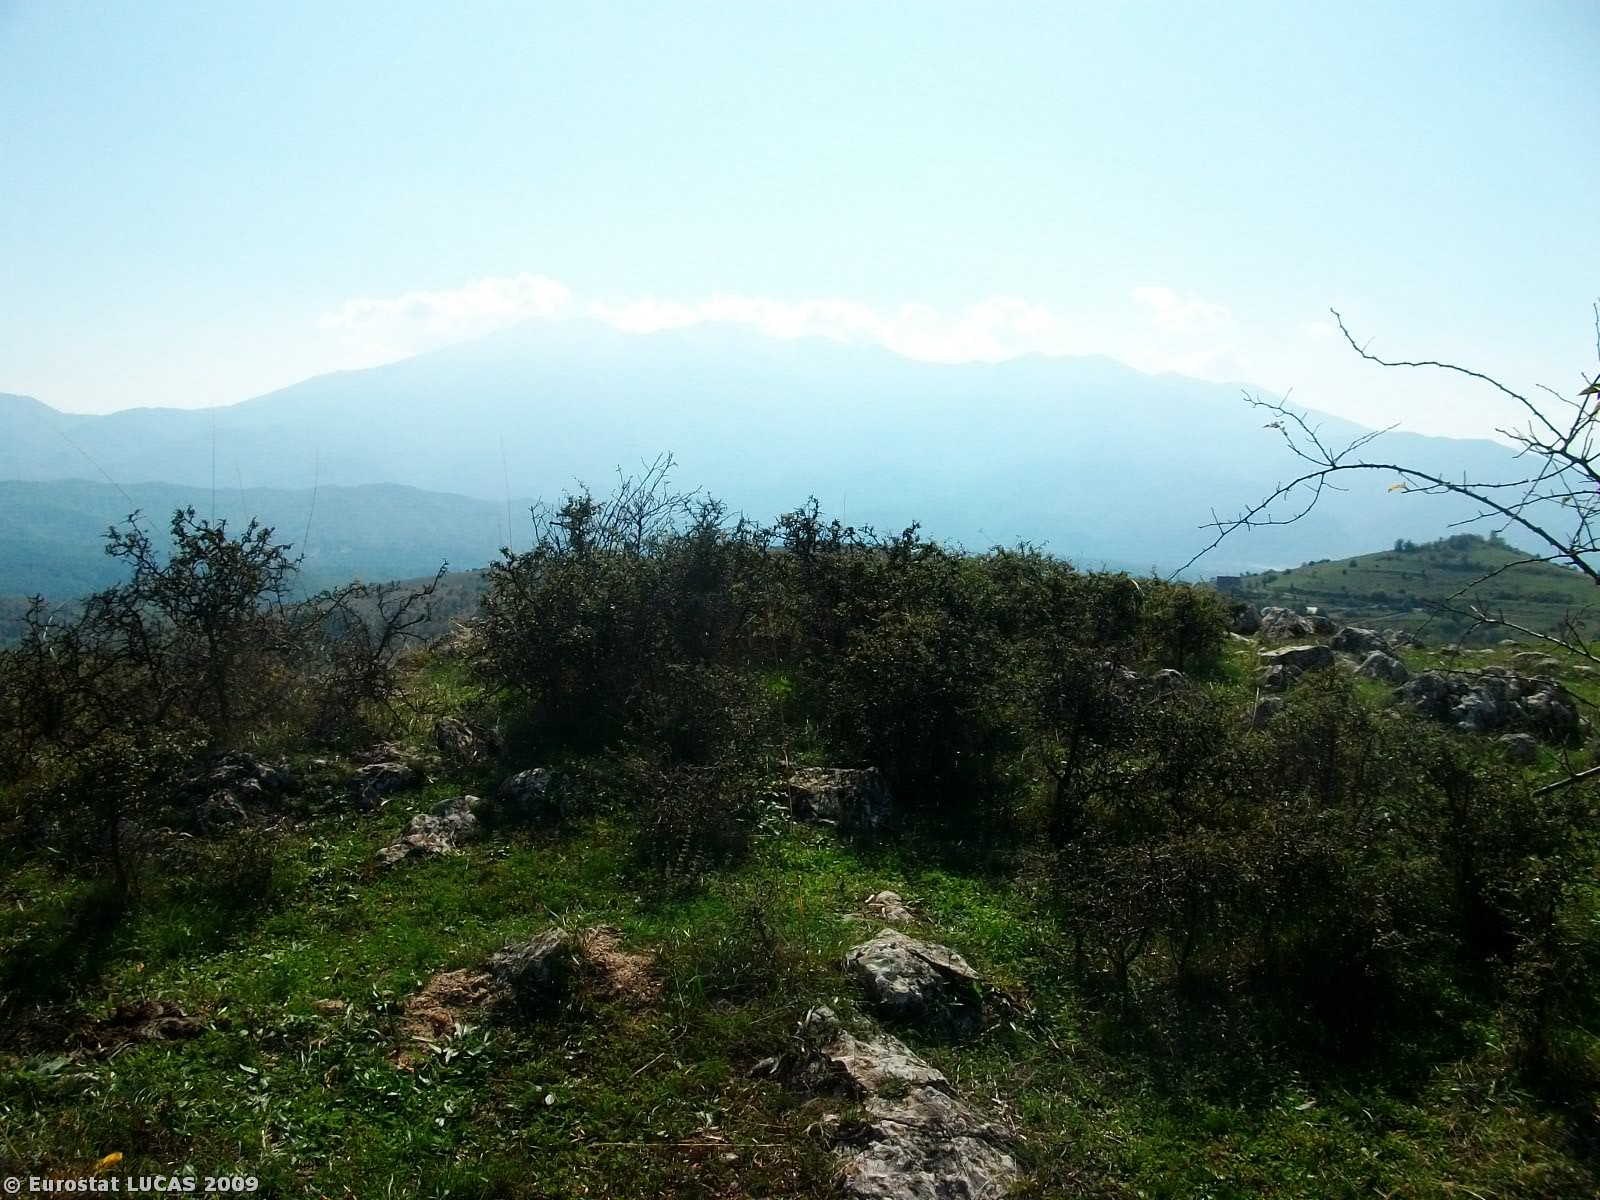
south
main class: Grassland
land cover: Grassland with sparse tree/shrub cover
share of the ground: 50 - 75 %
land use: Agriculture (excluding fallow land and kitchen gardens)
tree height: < 5 m
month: September
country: GR
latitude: 41.4151
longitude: 24.1622
